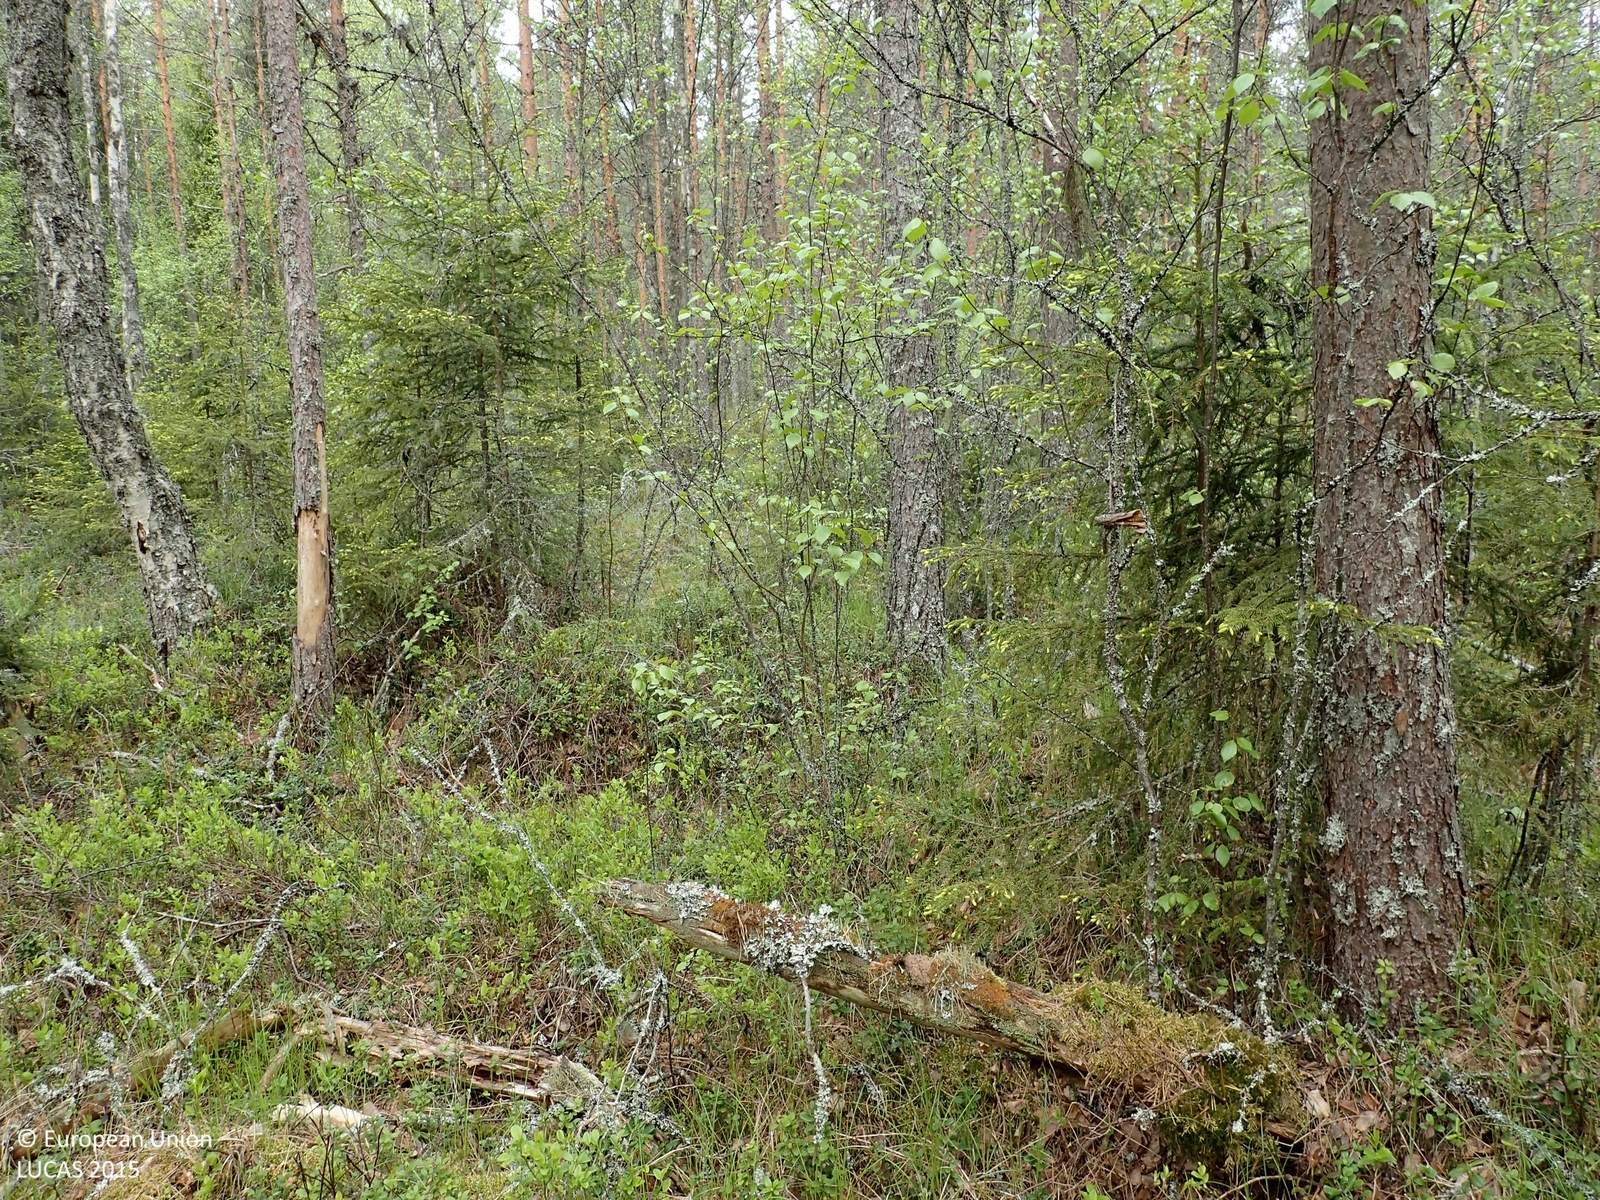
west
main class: Woodland
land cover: Pine dominated mixed woodland
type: boreal forest
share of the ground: > 75 %
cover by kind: coniferous forest trees 65 %, broadleaved forest trees 25 %, shrubs 10 %
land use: Forestry
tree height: > 5 m
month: June
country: FI
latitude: 62.2435
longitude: 21.7311
